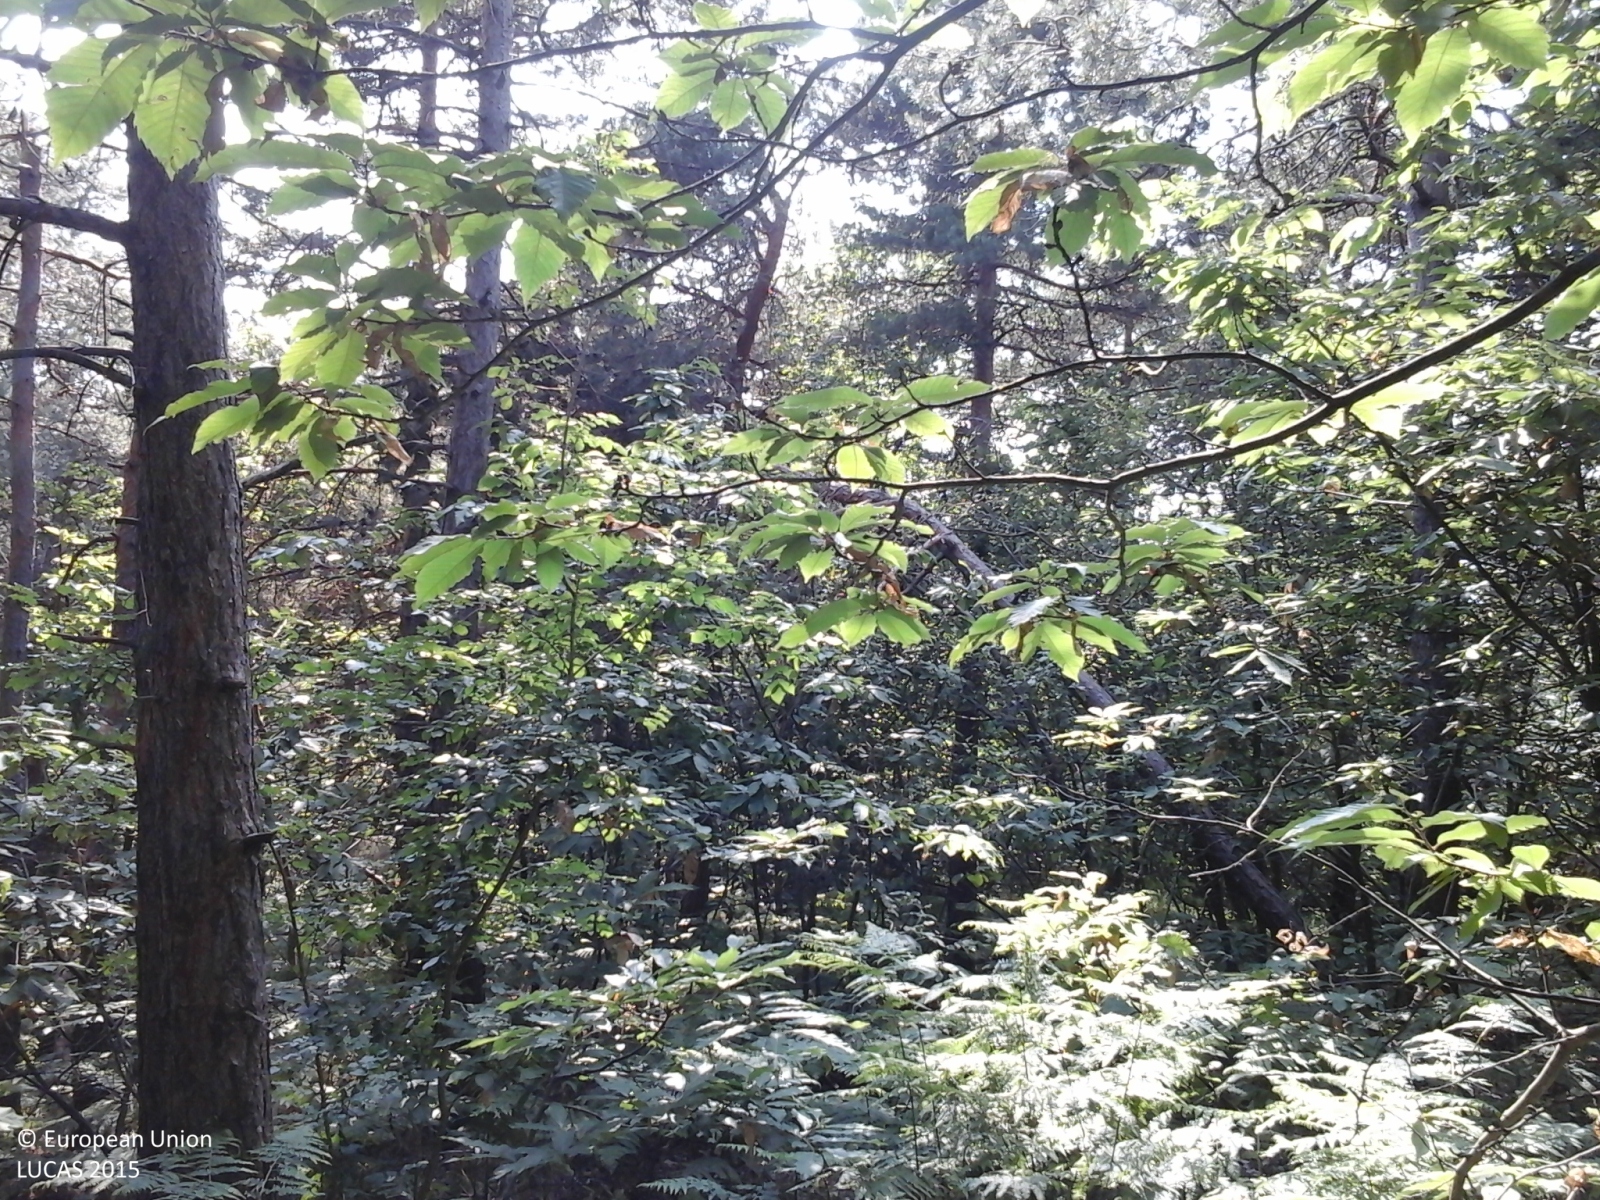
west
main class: Woodland
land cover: Broadleaved woodland
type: thermophilous deciduous forest
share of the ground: > 75 %
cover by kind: broadleaved forest trees 80 %, shrubs 20 %
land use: Forestry
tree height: > 5 m
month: June
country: IT
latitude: 44.5559
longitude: 8.4800
